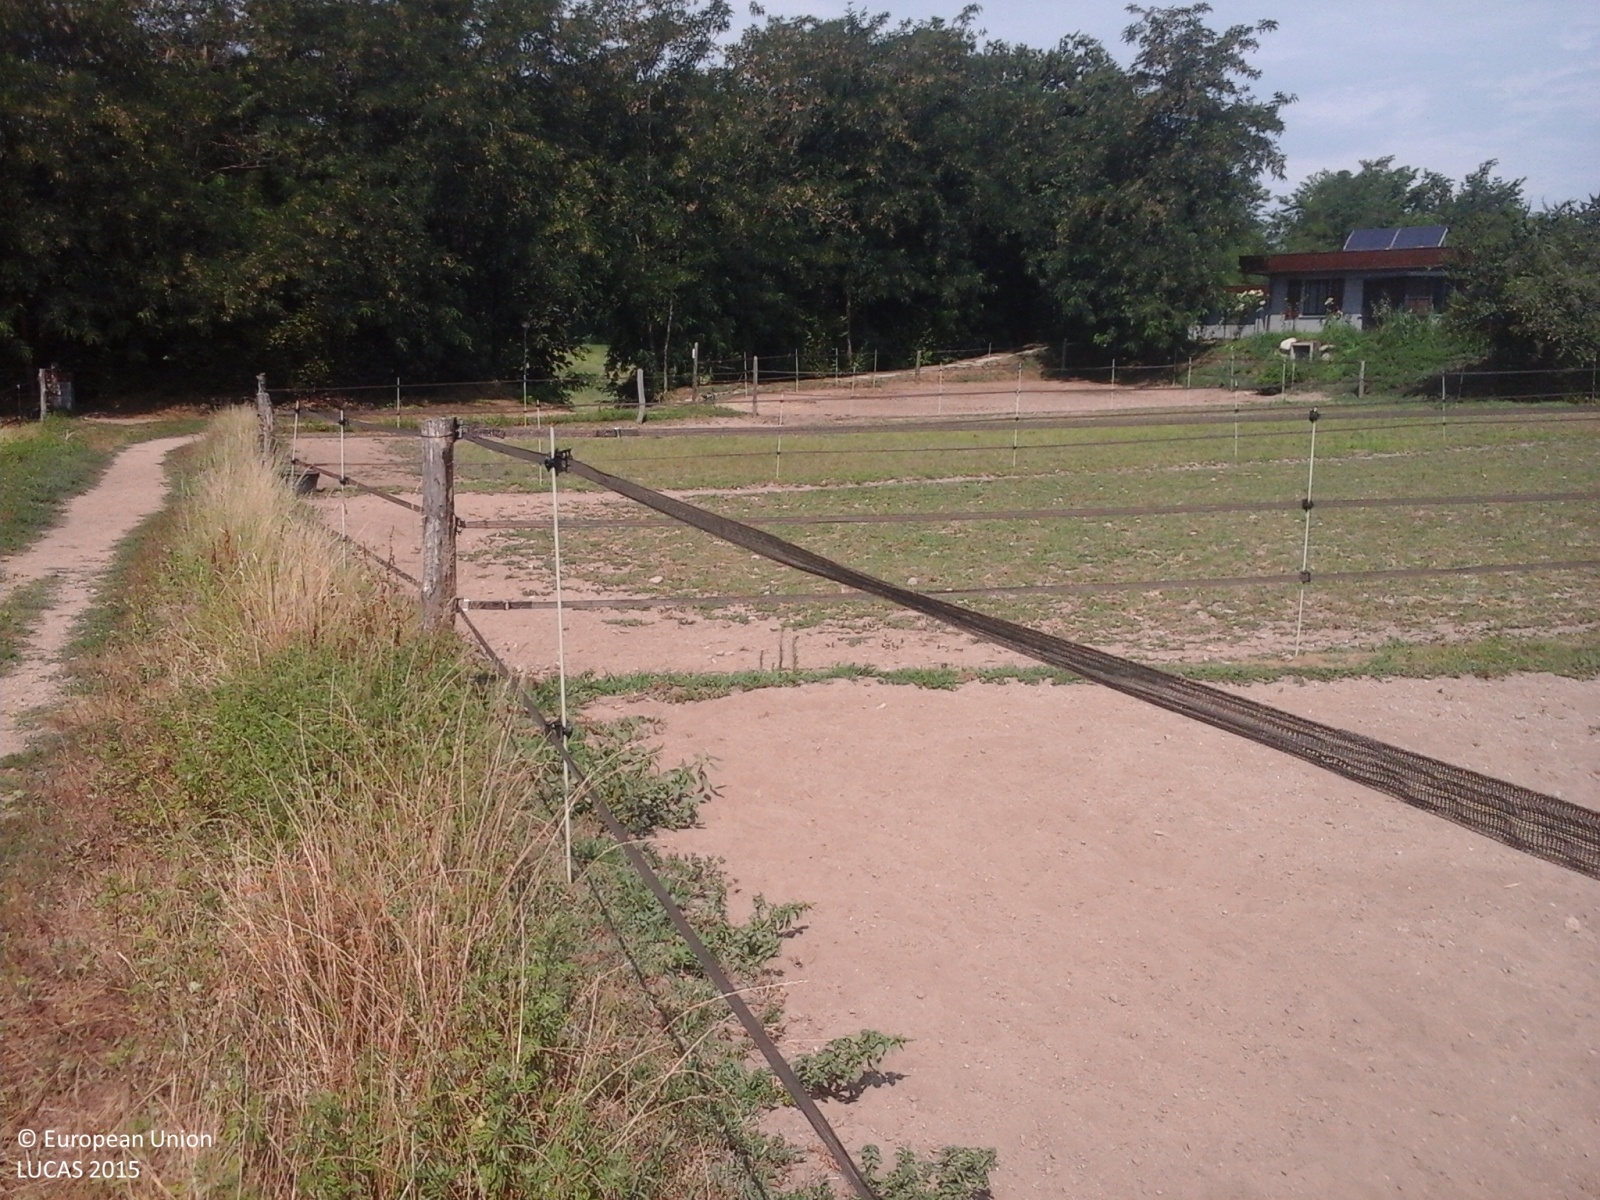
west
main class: Grassland
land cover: Grassland without tree/shrub cover
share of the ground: > 75 %
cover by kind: herbaceous plants 90 %, unconsolidated bare surface 10 %
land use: Agriculture (excluding fallow land and kitchen gardens)
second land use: Amenities, museums, leisure
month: July
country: IT
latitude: 45.8592
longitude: 8.9069
